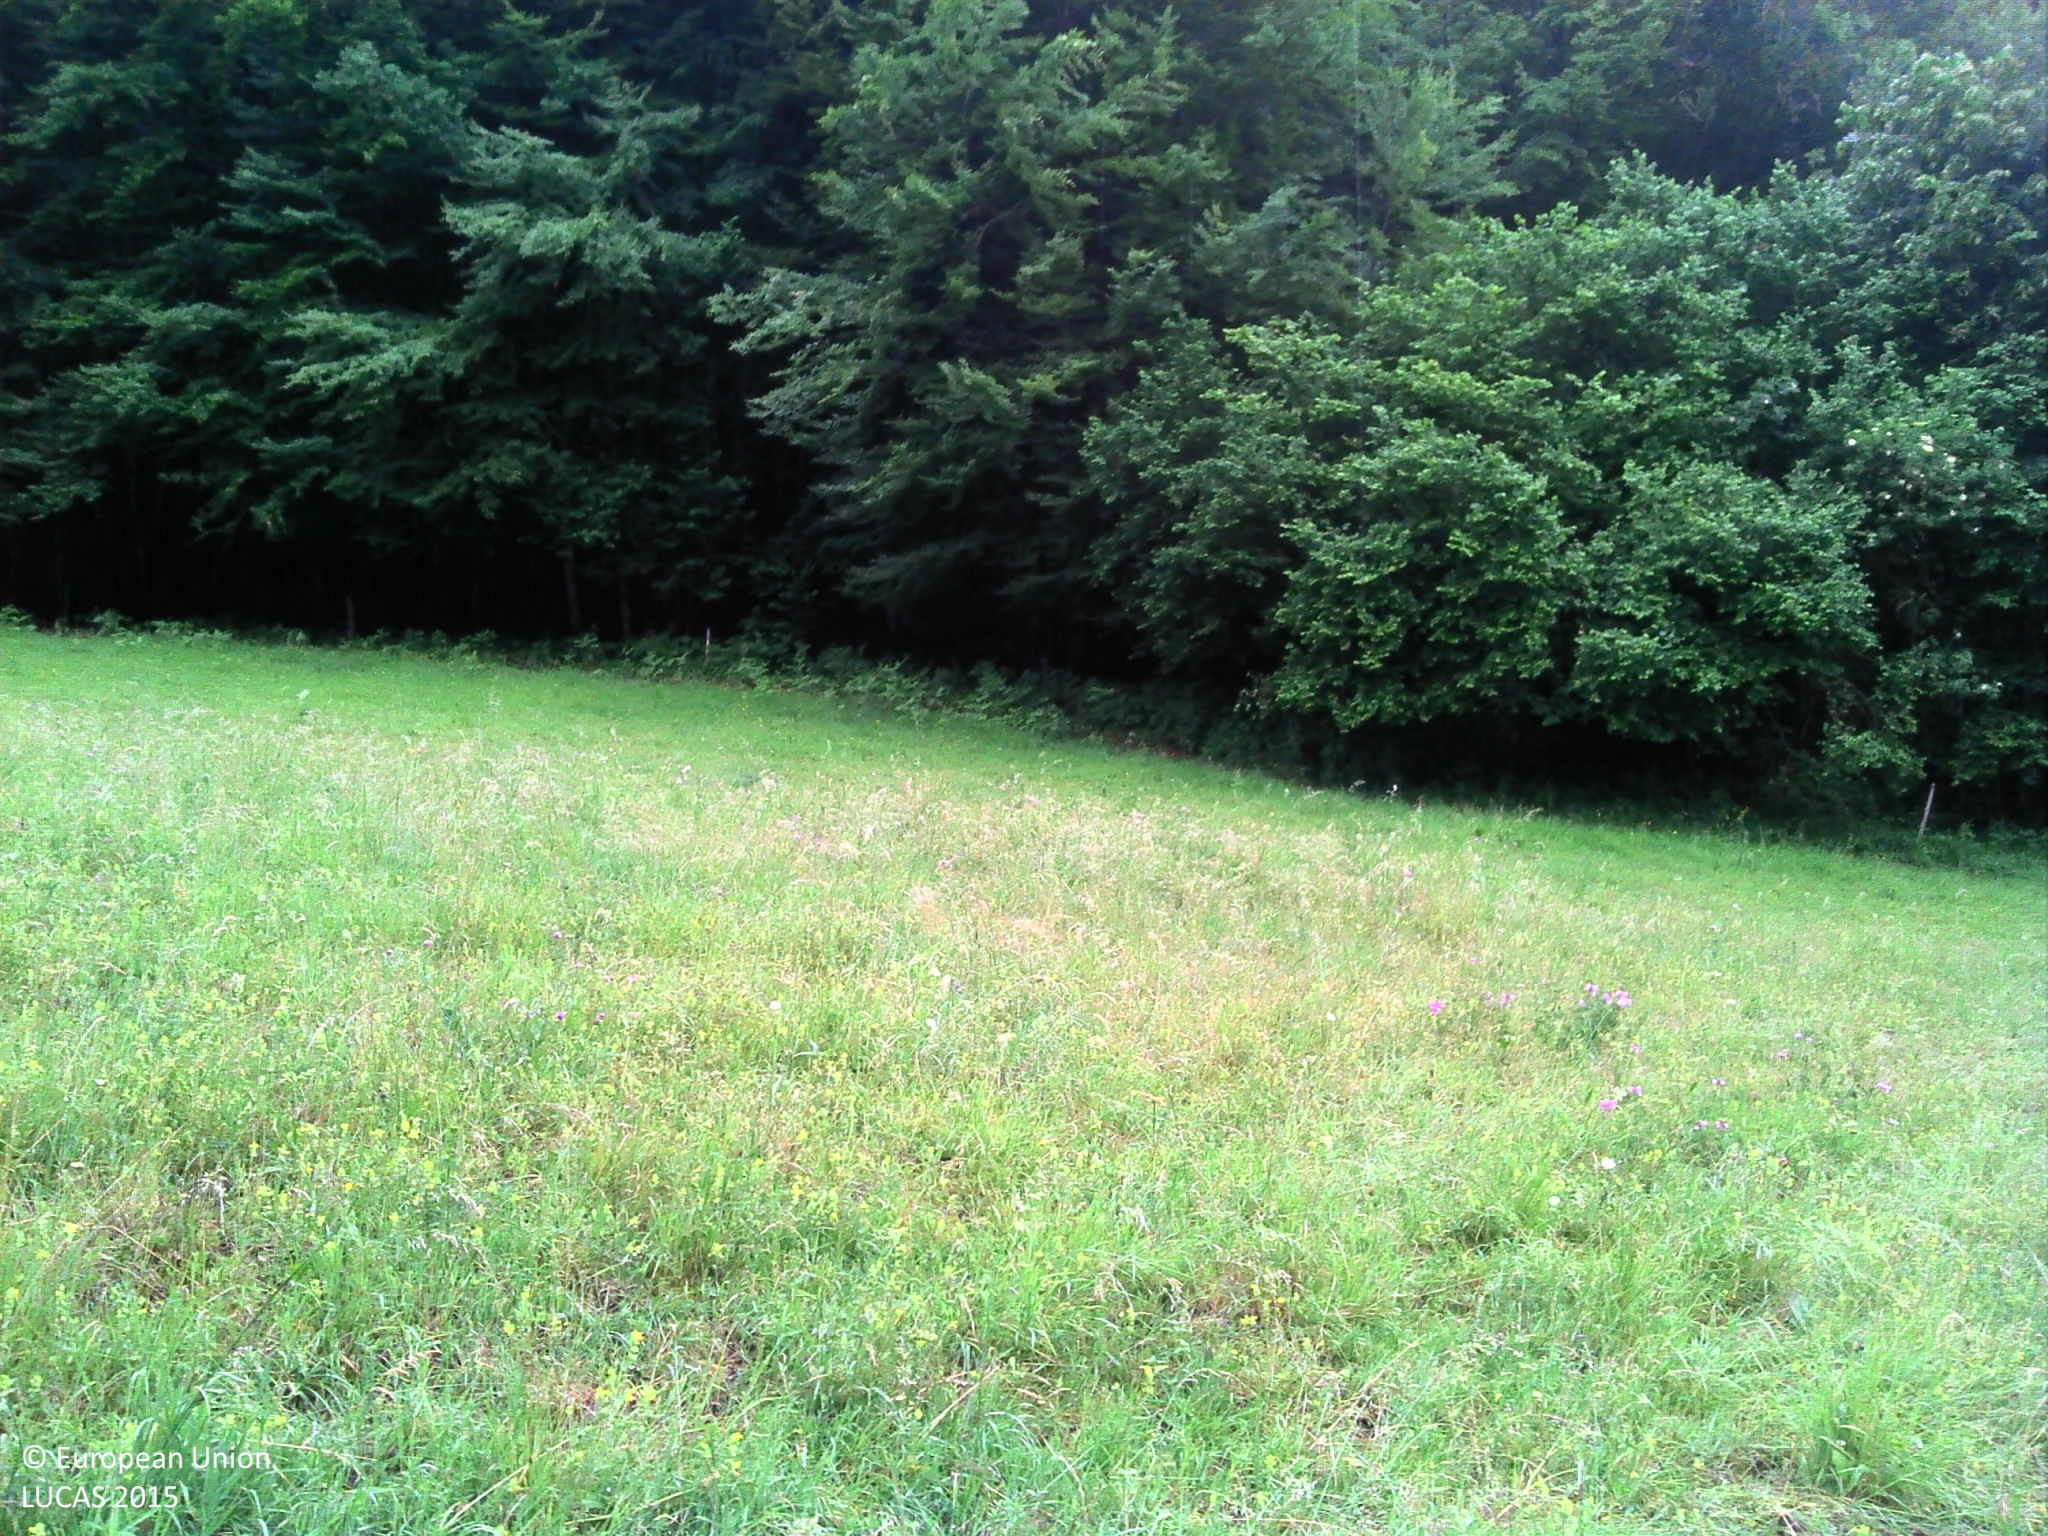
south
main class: Grassland
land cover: Grassland without tree/shrub cover
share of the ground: > 75 %
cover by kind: herbaceous plants 100 %
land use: Agriculture (excluding fallow land and kitchen gardens)
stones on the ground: 10 - 25 %
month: June
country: FR
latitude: 44.9665
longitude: 2.5076
